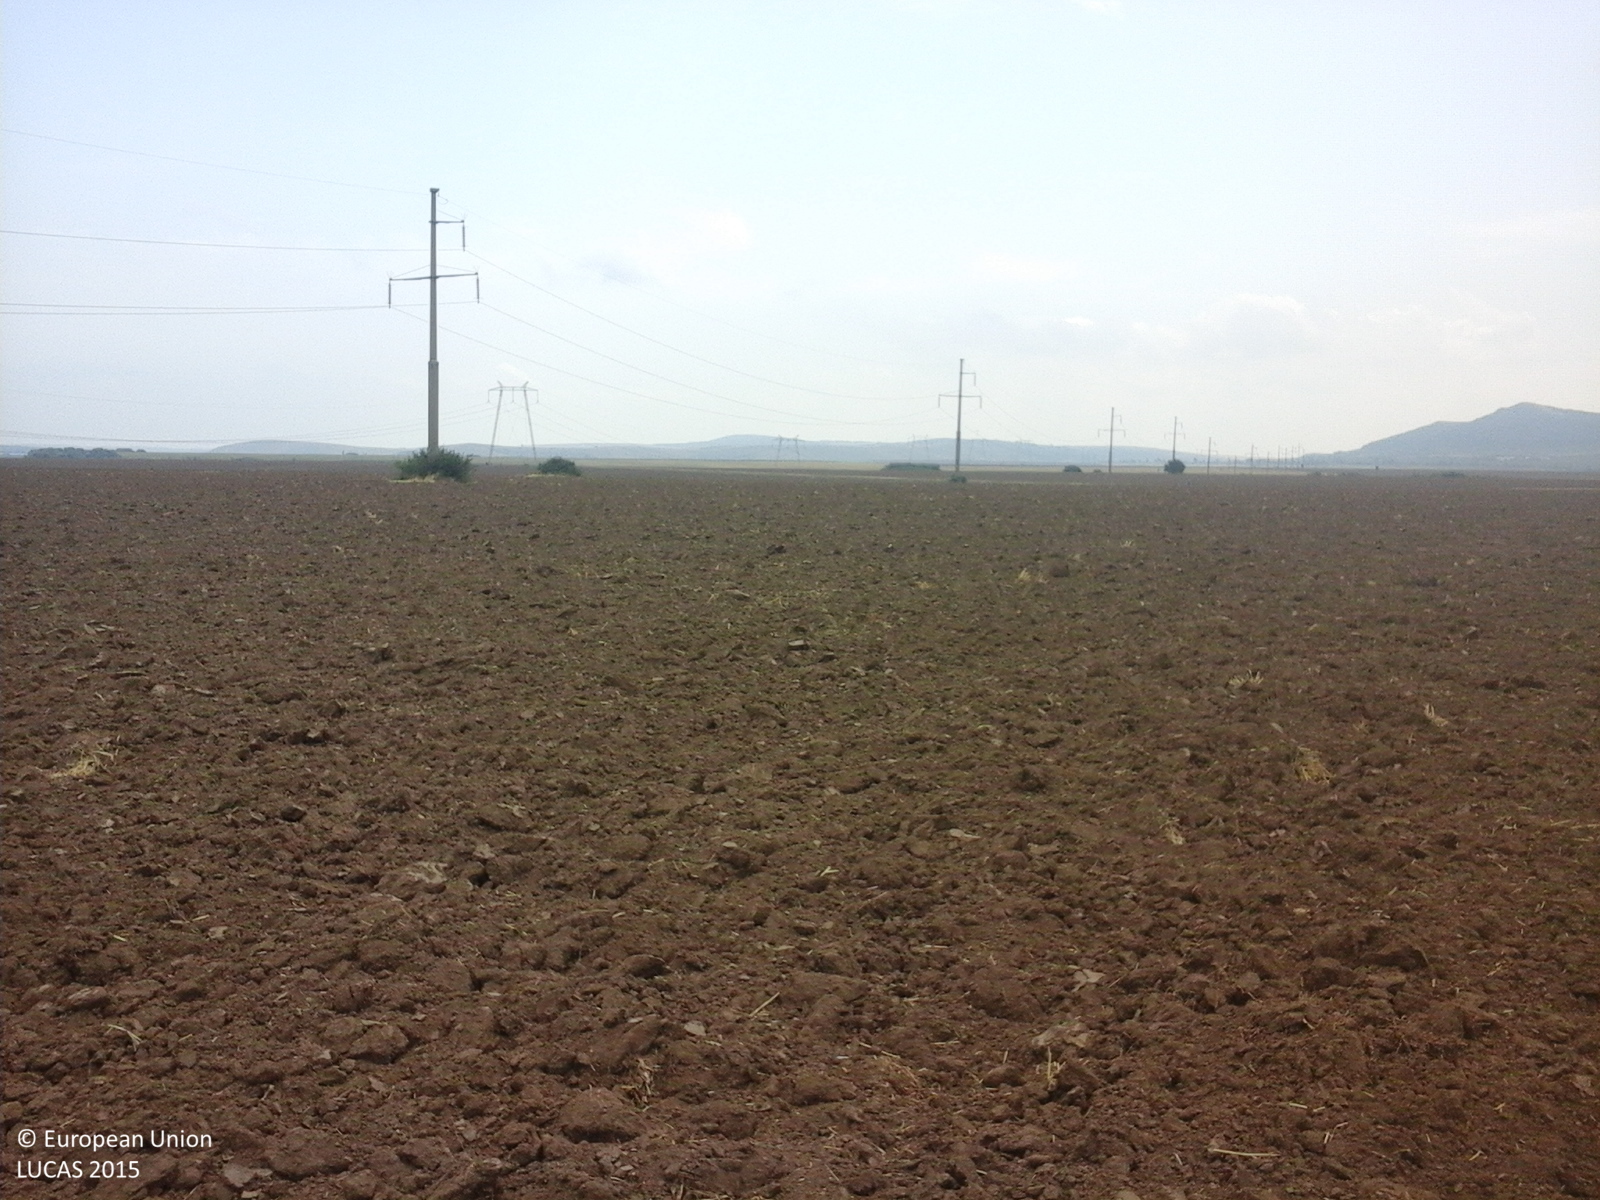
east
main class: Cropland
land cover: Common wheat
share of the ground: < 10 %
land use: Agriculture (excluding fallow land and kitchen gardens)
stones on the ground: < 10 %
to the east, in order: Common wheat; Electric lines; Common wheat
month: July
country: RO
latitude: 45.2208
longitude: 28.4815
